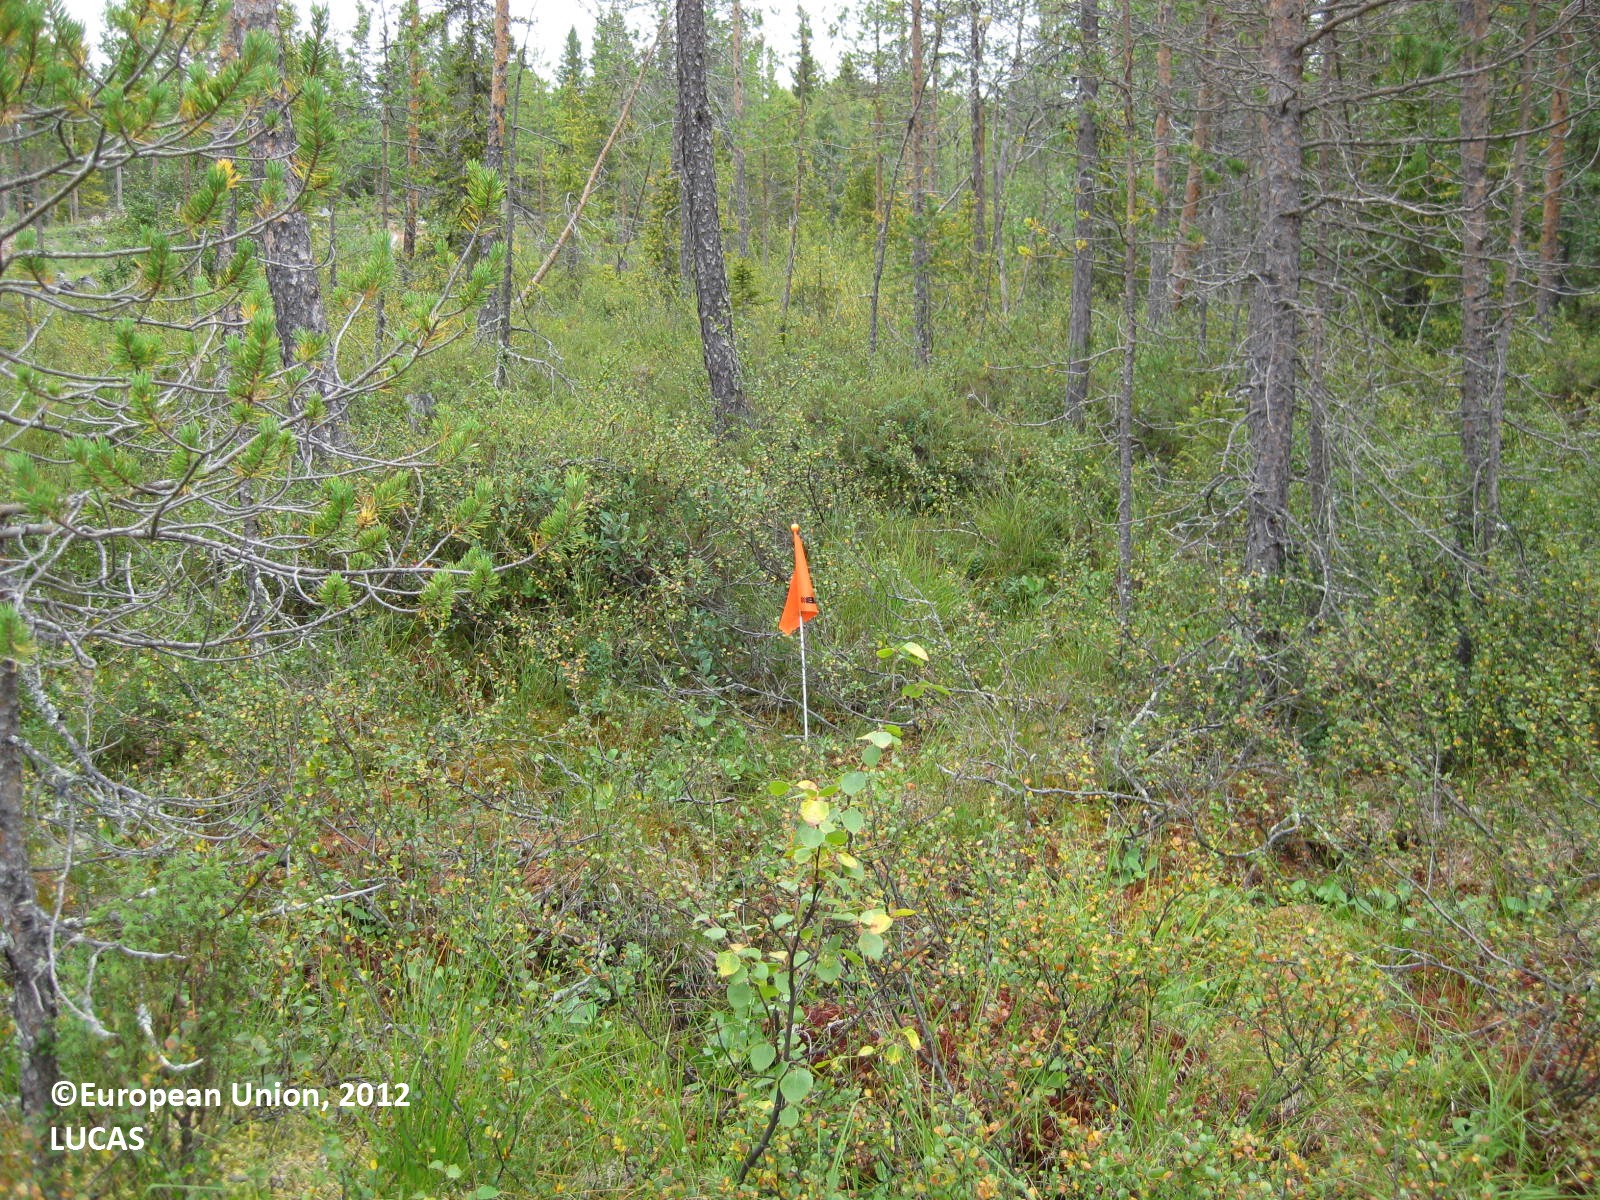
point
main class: Woodland
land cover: Pine dominated coniferous woodland
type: boreal forest
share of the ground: 50 - 75 %
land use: Forestry
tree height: > 5 m
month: August
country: FI
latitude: 66.4643
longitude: 29.0855
